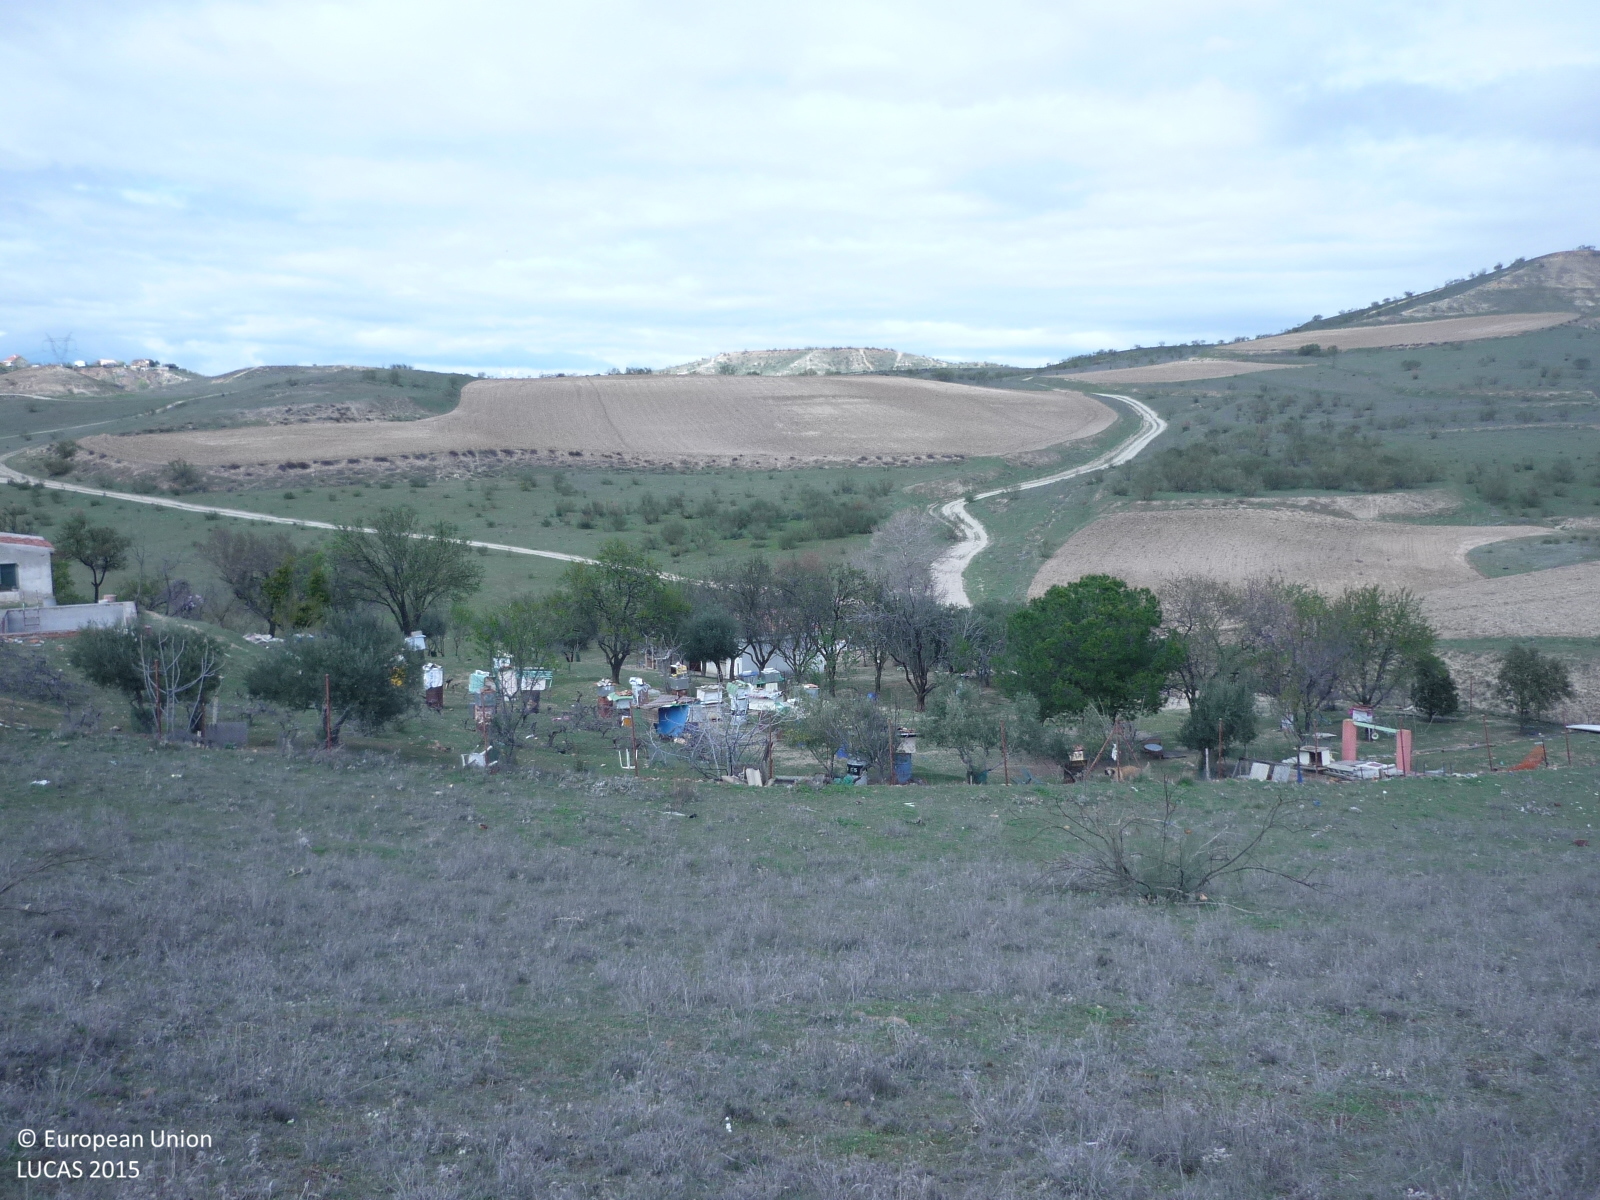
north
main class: Grassland
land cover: Grassland without tree/shrub cover
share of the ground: > 75 %
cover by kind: herbaceous plants 95 %, shrubs 5 %
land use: Semi-natural and natural areas not in use
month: March
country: ES
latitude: 40.5161
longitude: -3.5268
